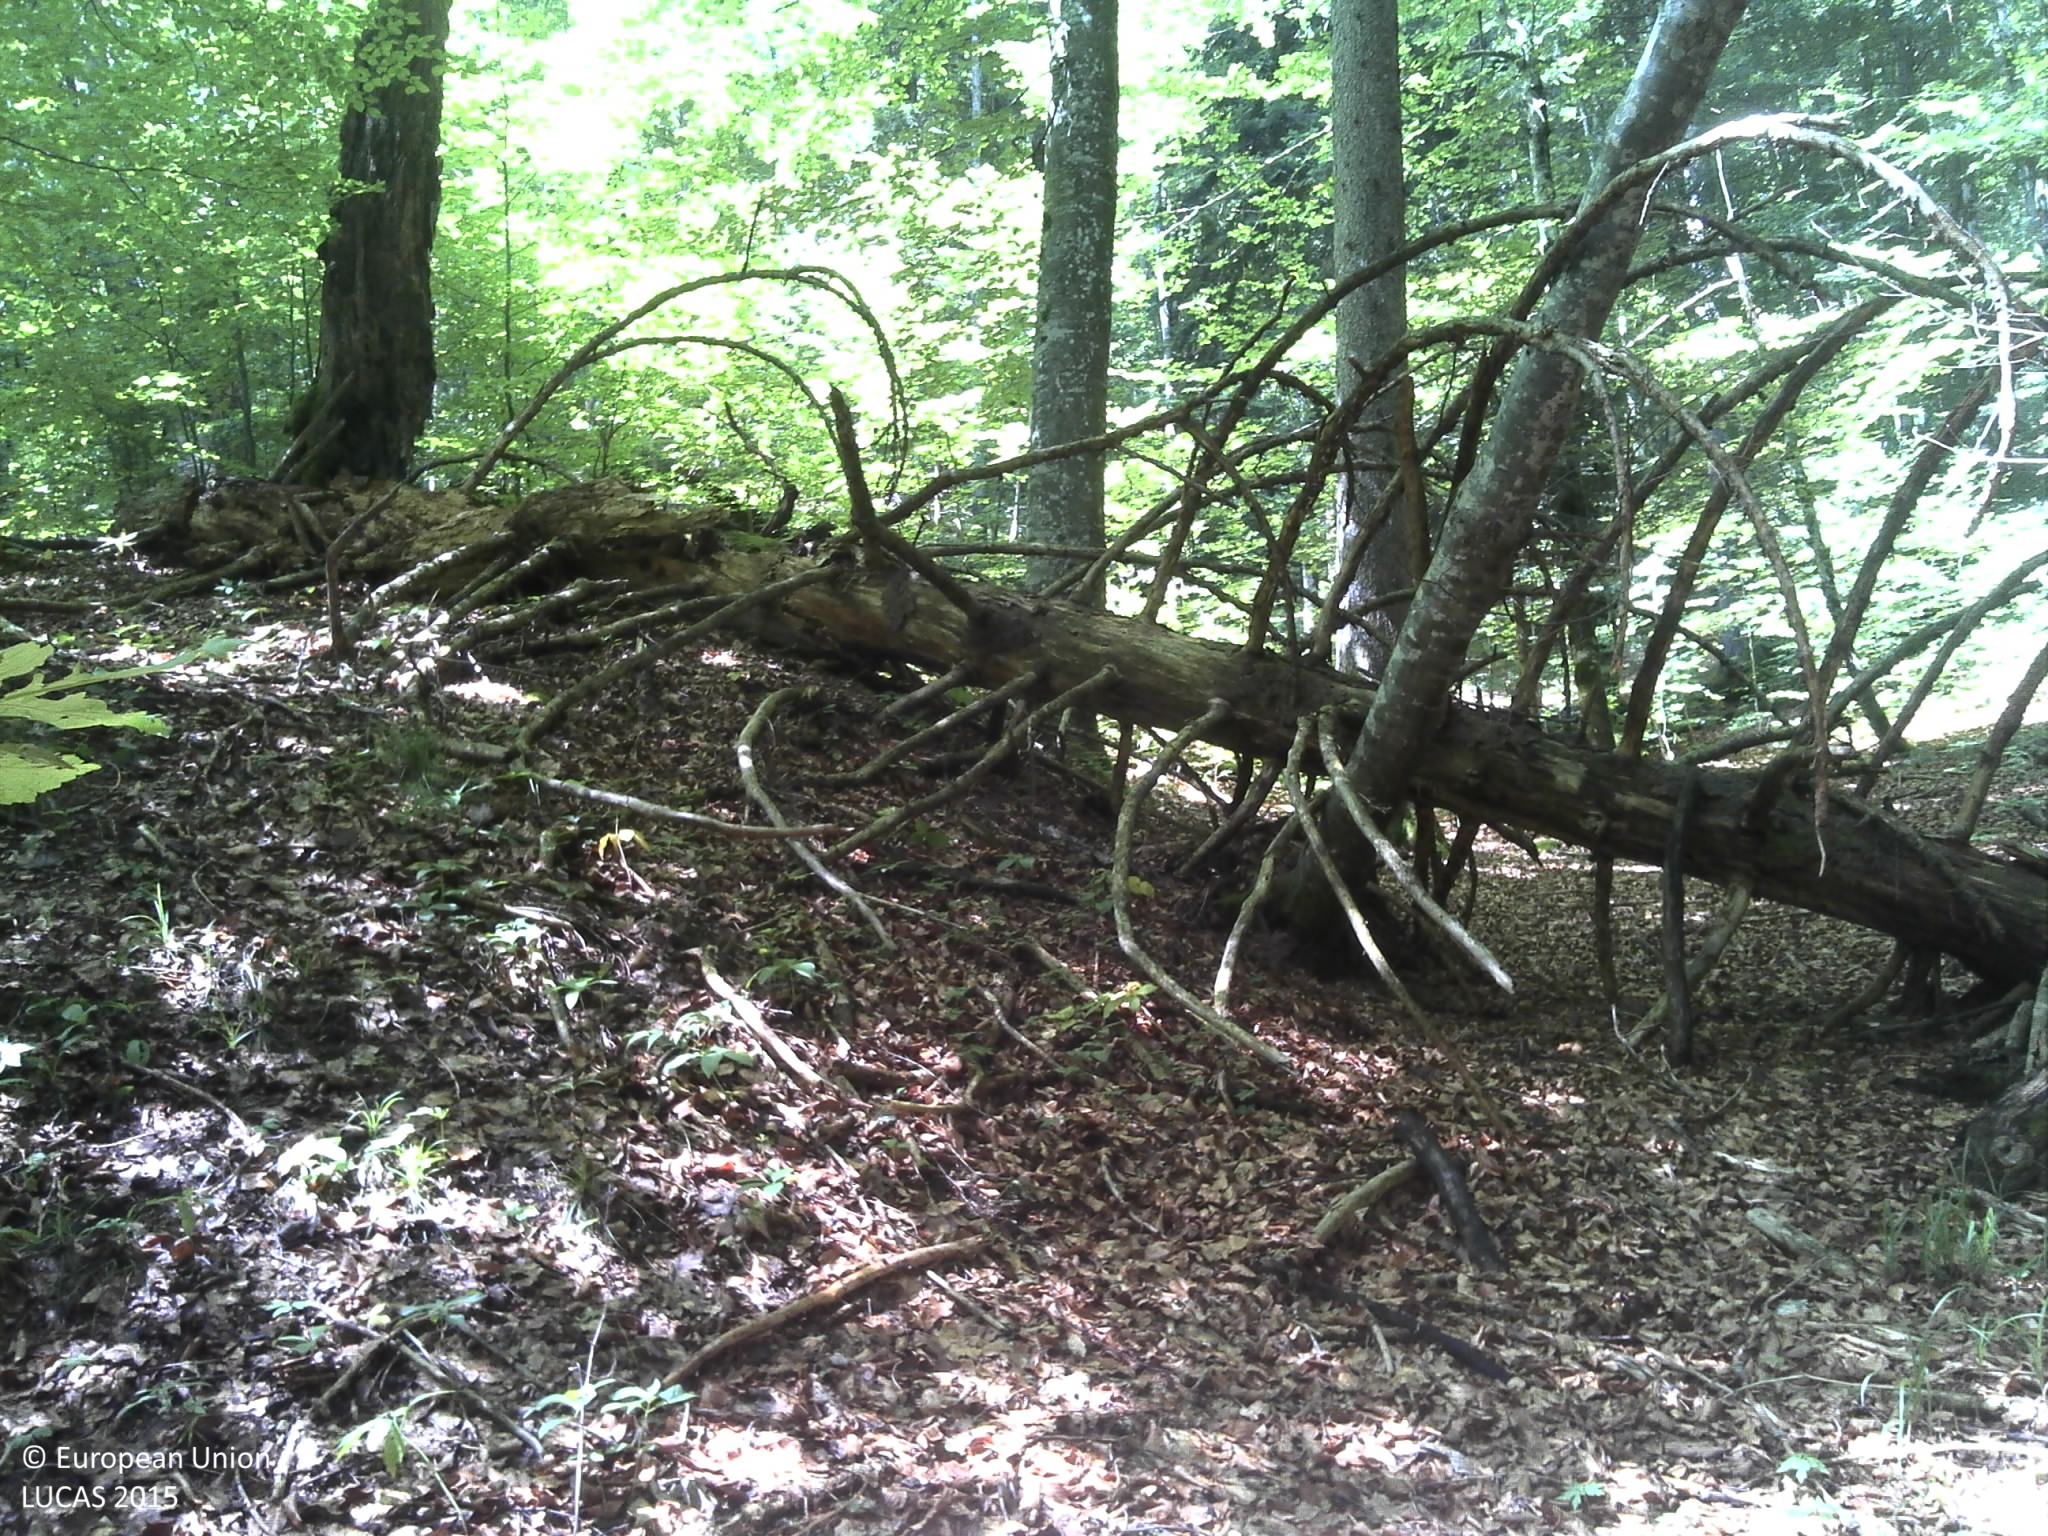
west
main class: Woodland
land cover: Broadleaved woodland
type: beech forest
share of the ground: > 75 %
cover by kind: broadleaved forest trees 95 %, consolidated bare surface 5 %
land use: Semi-natural and natural areas not in use
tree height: > 5 m
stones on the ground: < 10 %
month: June
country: HR
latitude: 44.8486
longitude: 15.6249
